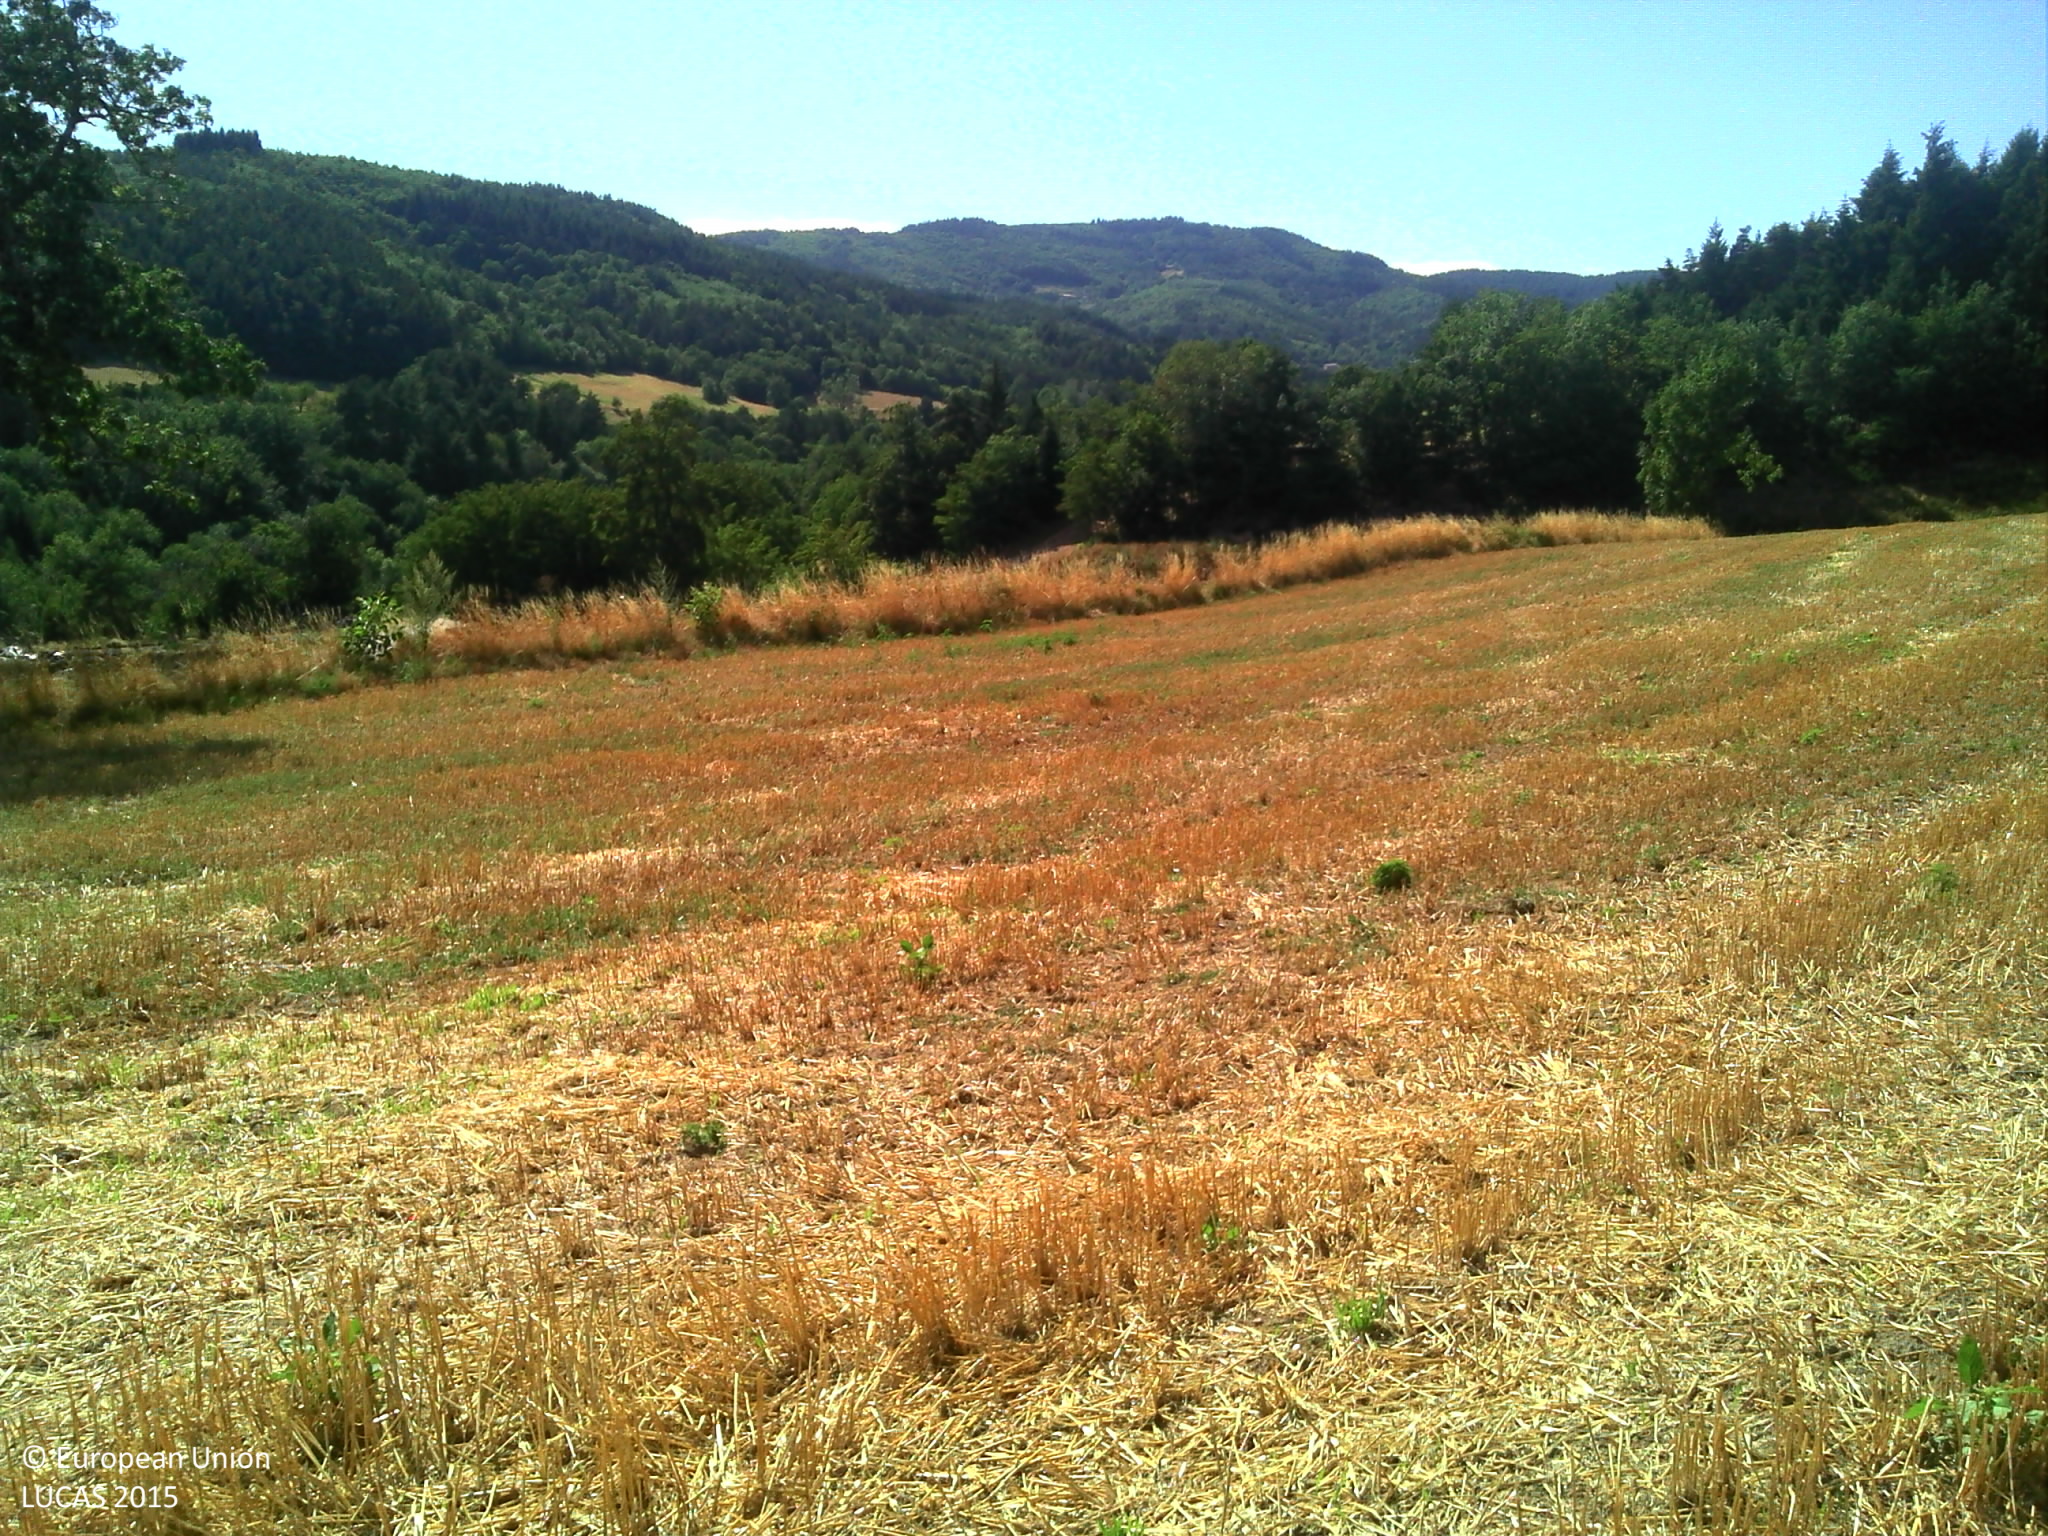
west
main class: Cropland
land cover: Barley
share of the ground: > 75 %
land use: Agriculture (excluding fallow land and kitchen gardens)
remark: Harvested field
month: July
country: FR
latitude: 44.9145
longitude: 4.5967
